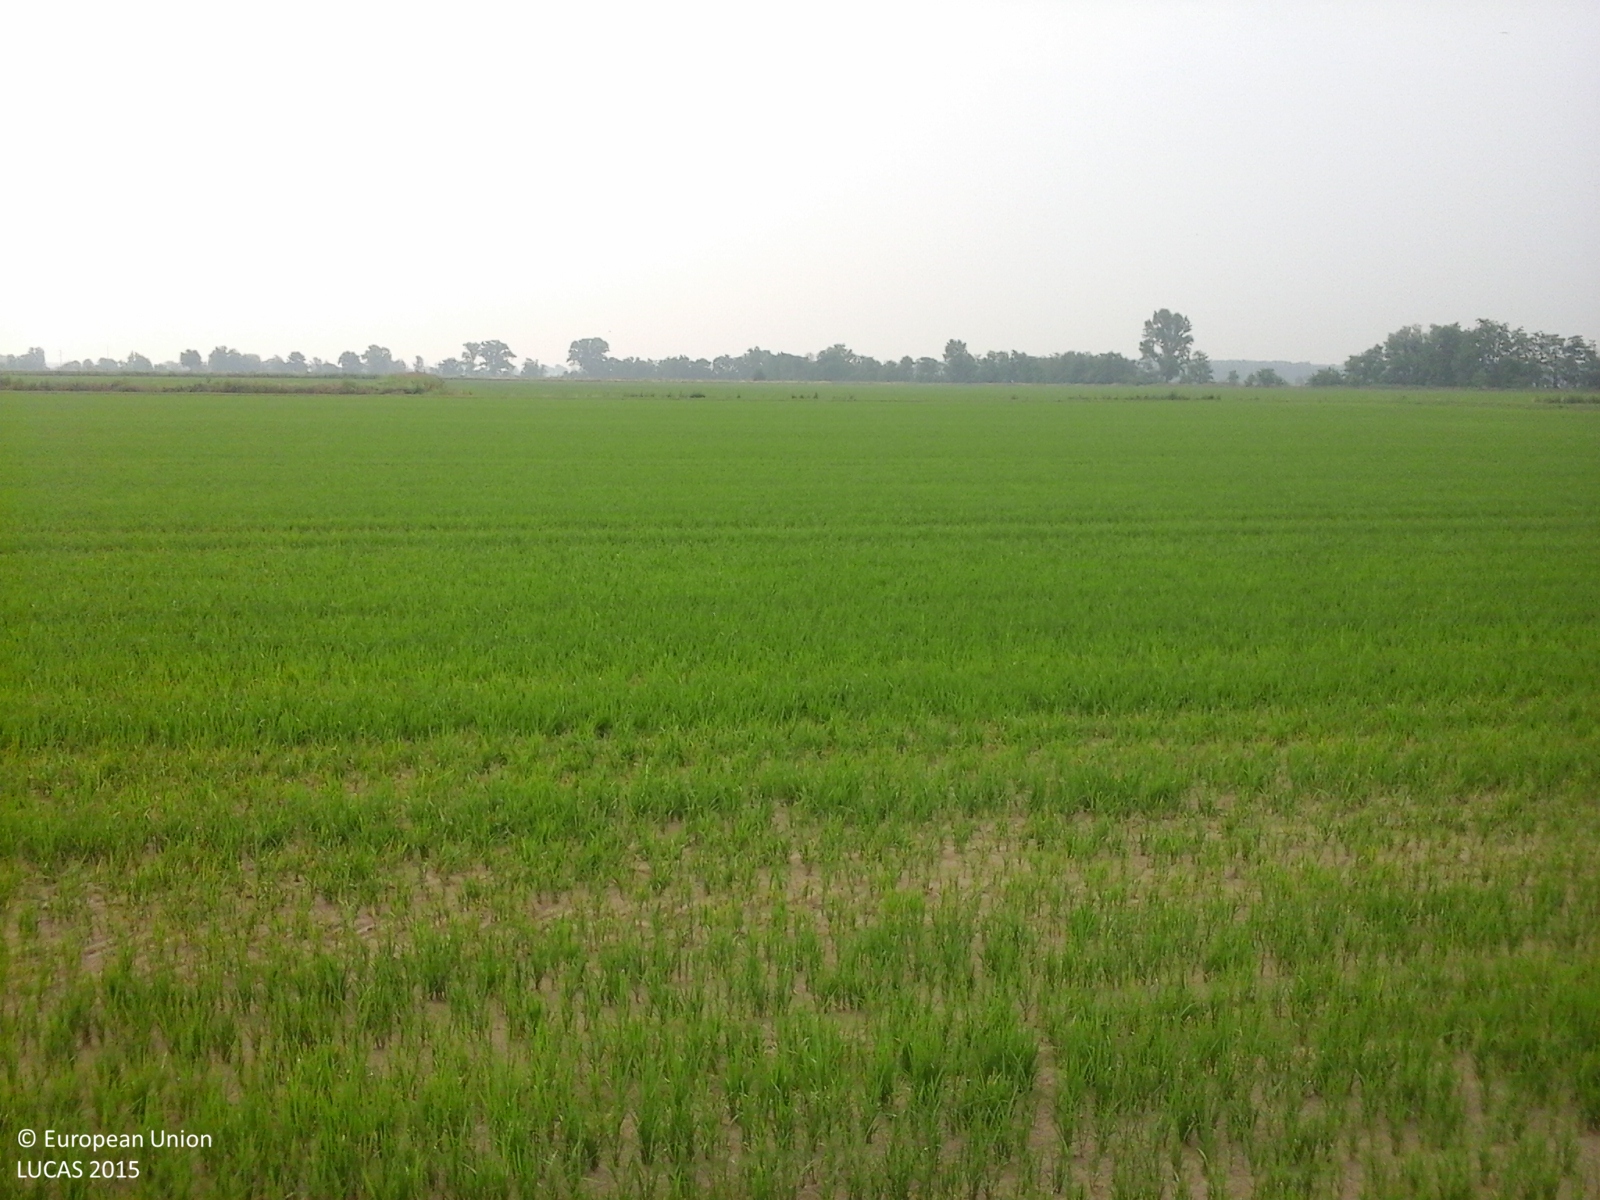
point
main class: Cropland
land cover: Rice
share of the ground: 50 - 75 %
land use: Agriculture (excluding fallow land and kitchen gardens)
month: June
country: IT
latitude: 45.1722
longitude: 8.7172
